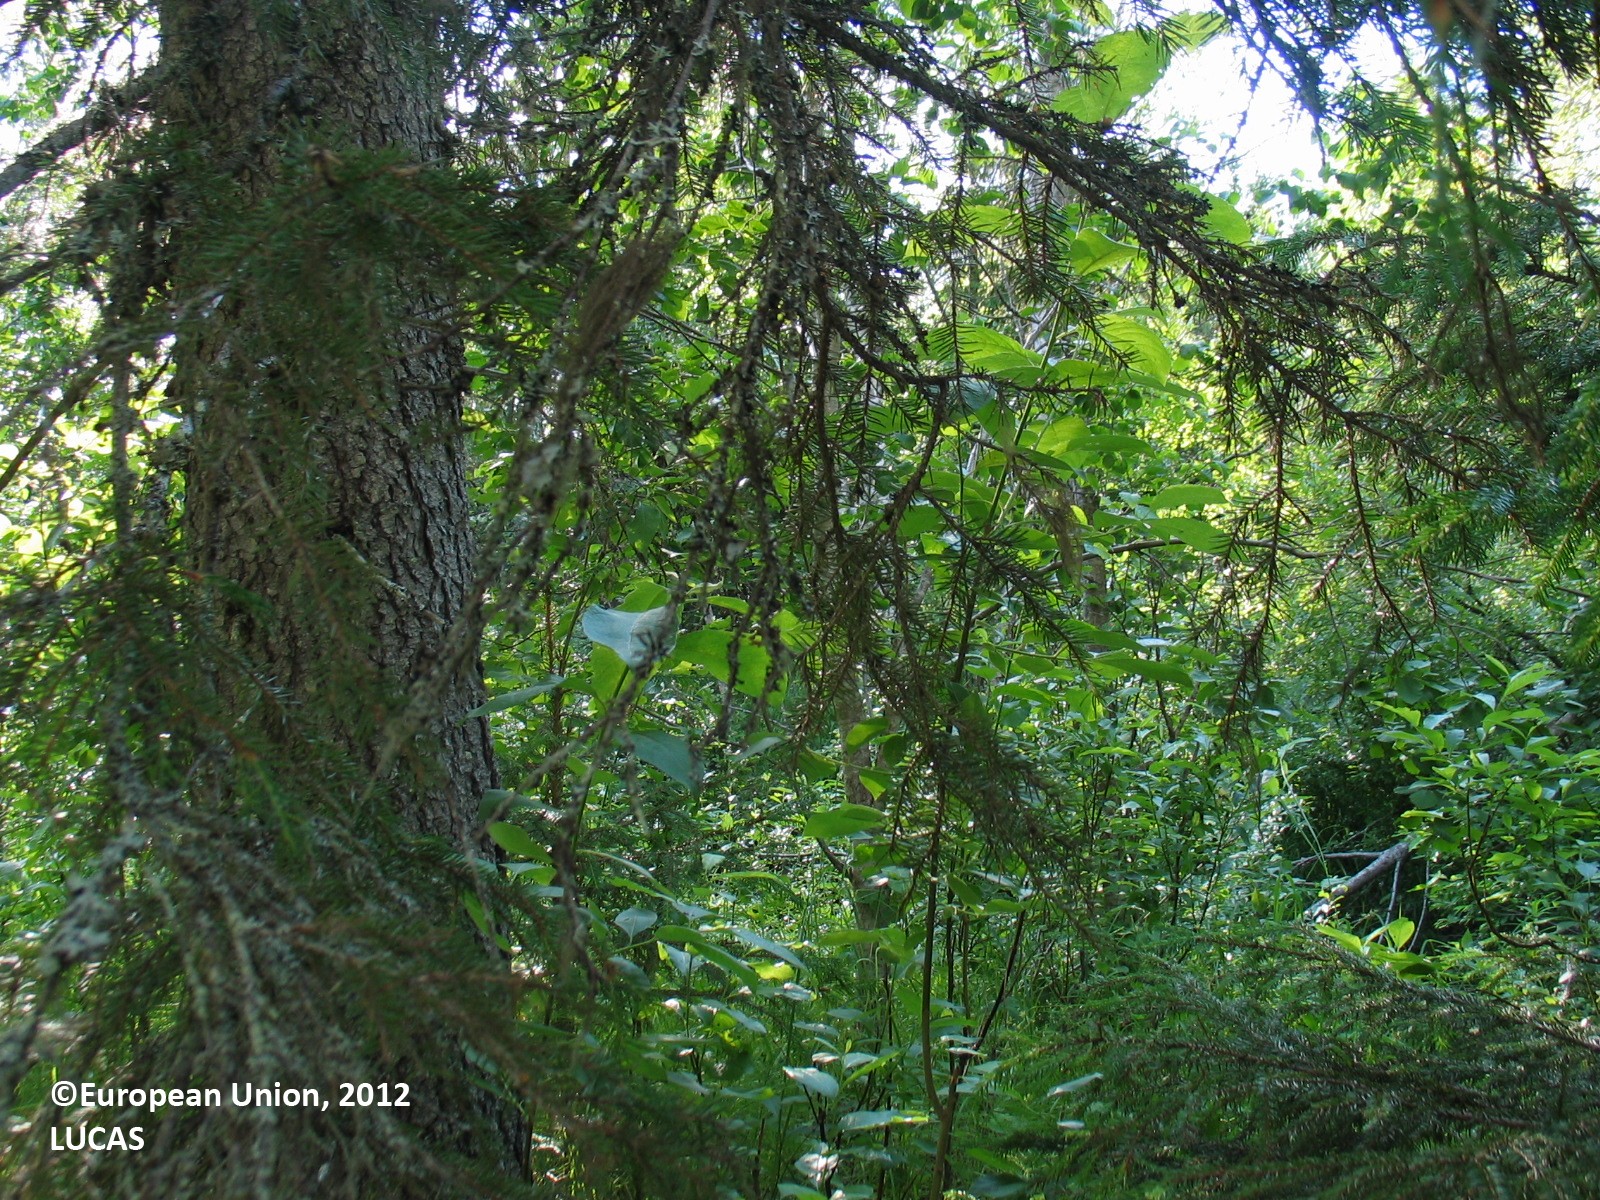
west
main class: Woodland
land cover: Other mixed woodland
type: boreal forest
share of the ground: 50 - 75 %
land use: Forestry
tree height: > 5 m
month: July
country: FI
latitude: 65.9546
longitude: 25.1746
